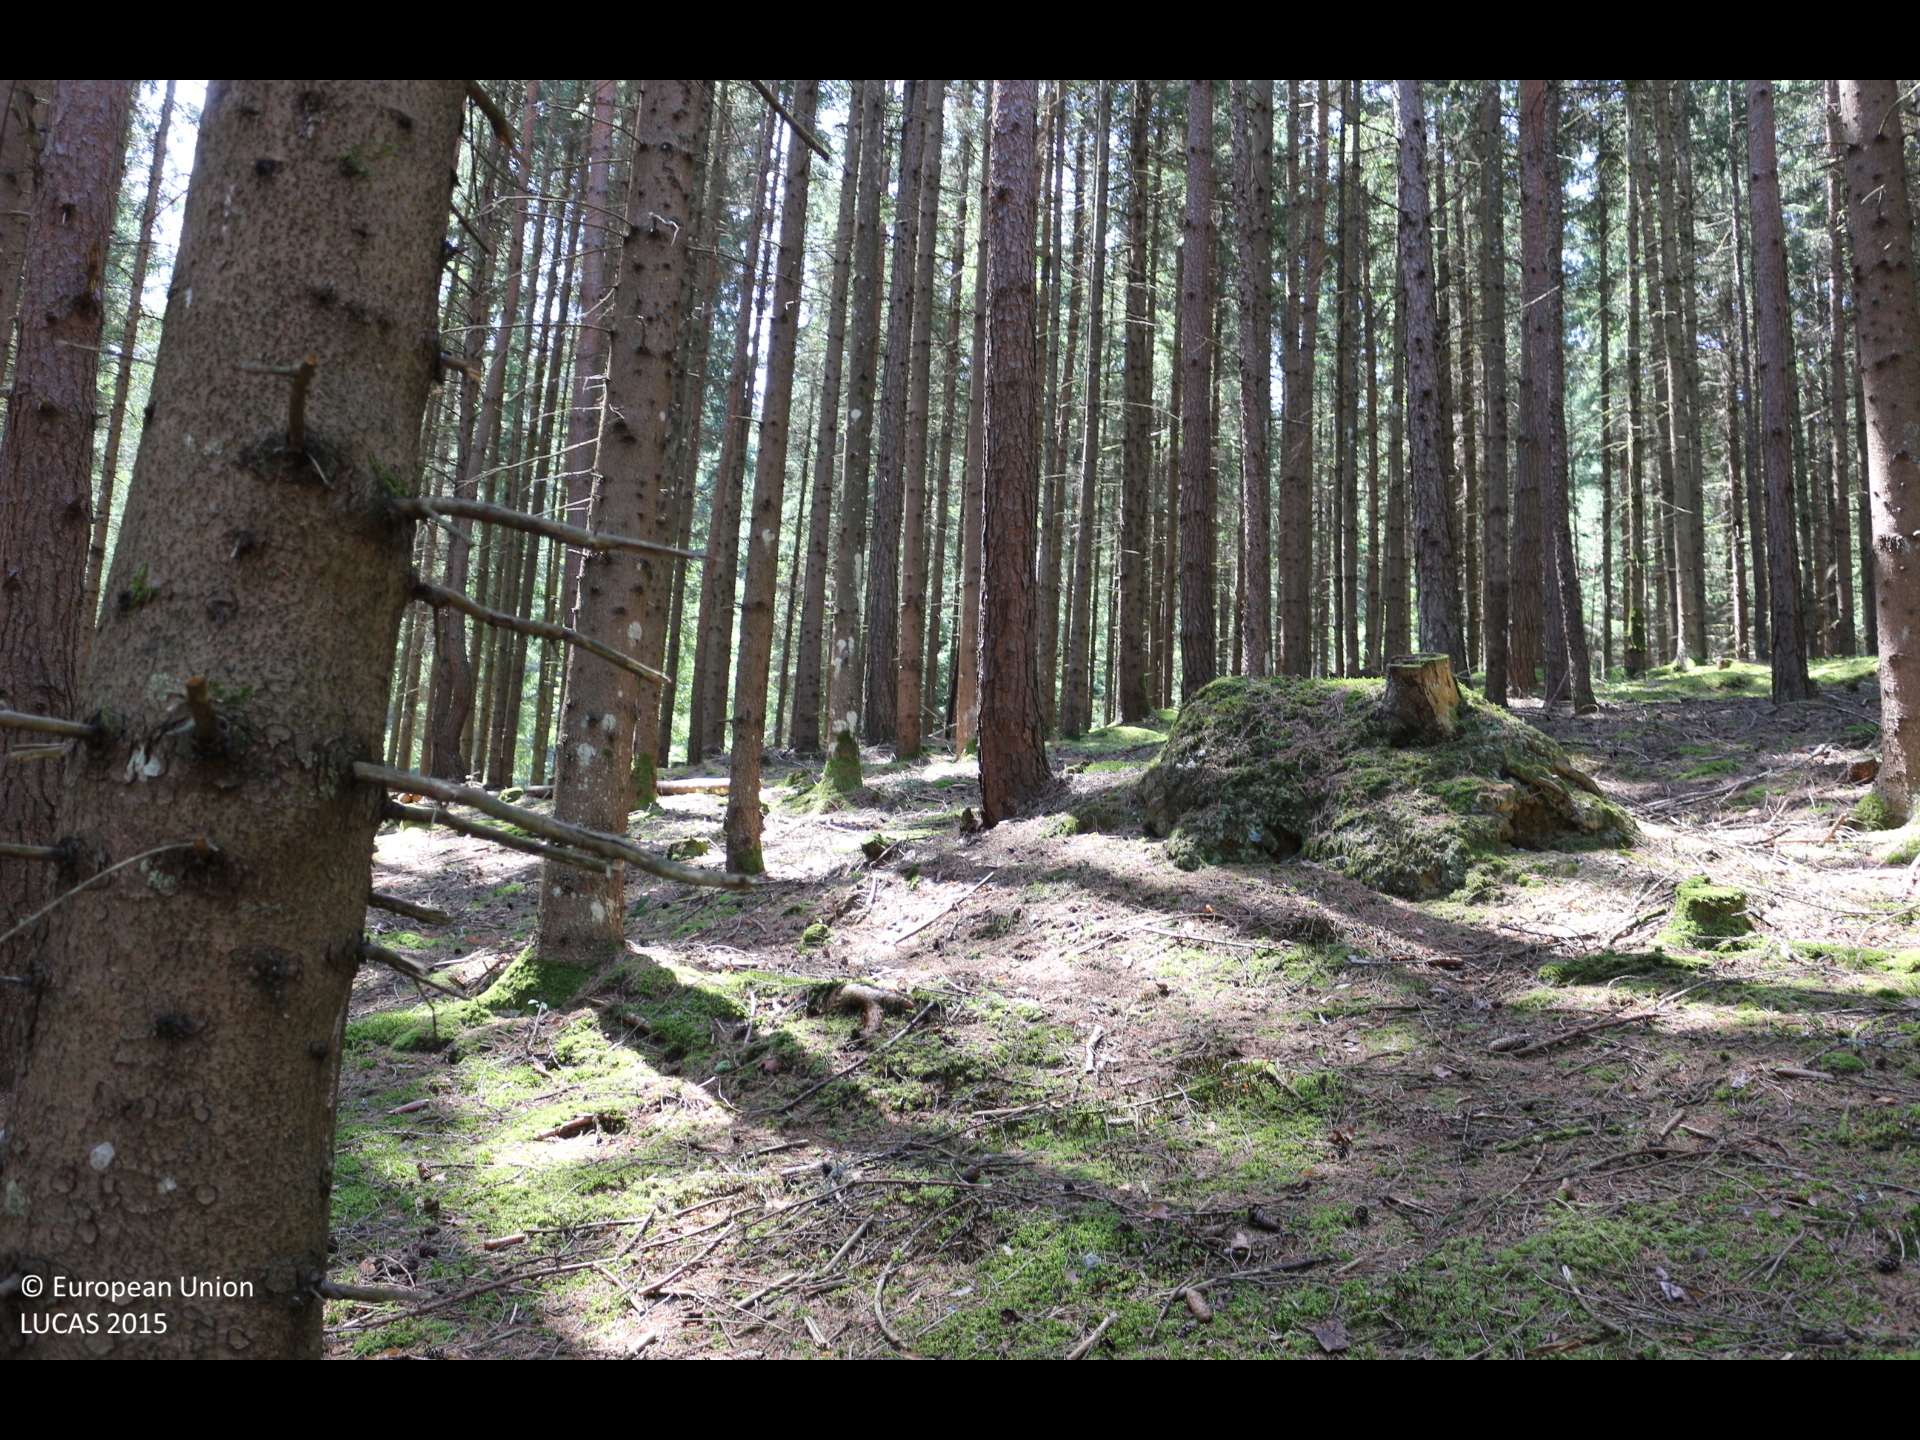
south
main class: Woodland
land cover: Spruce dominated coniferous woodland
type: alpine coniferous forest
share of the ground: > 75 %
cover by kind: coniferous forest trees 100 %
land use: Forestry
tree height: > 5 m
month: July
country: AT
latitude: 46.7235
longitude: 13.5954
